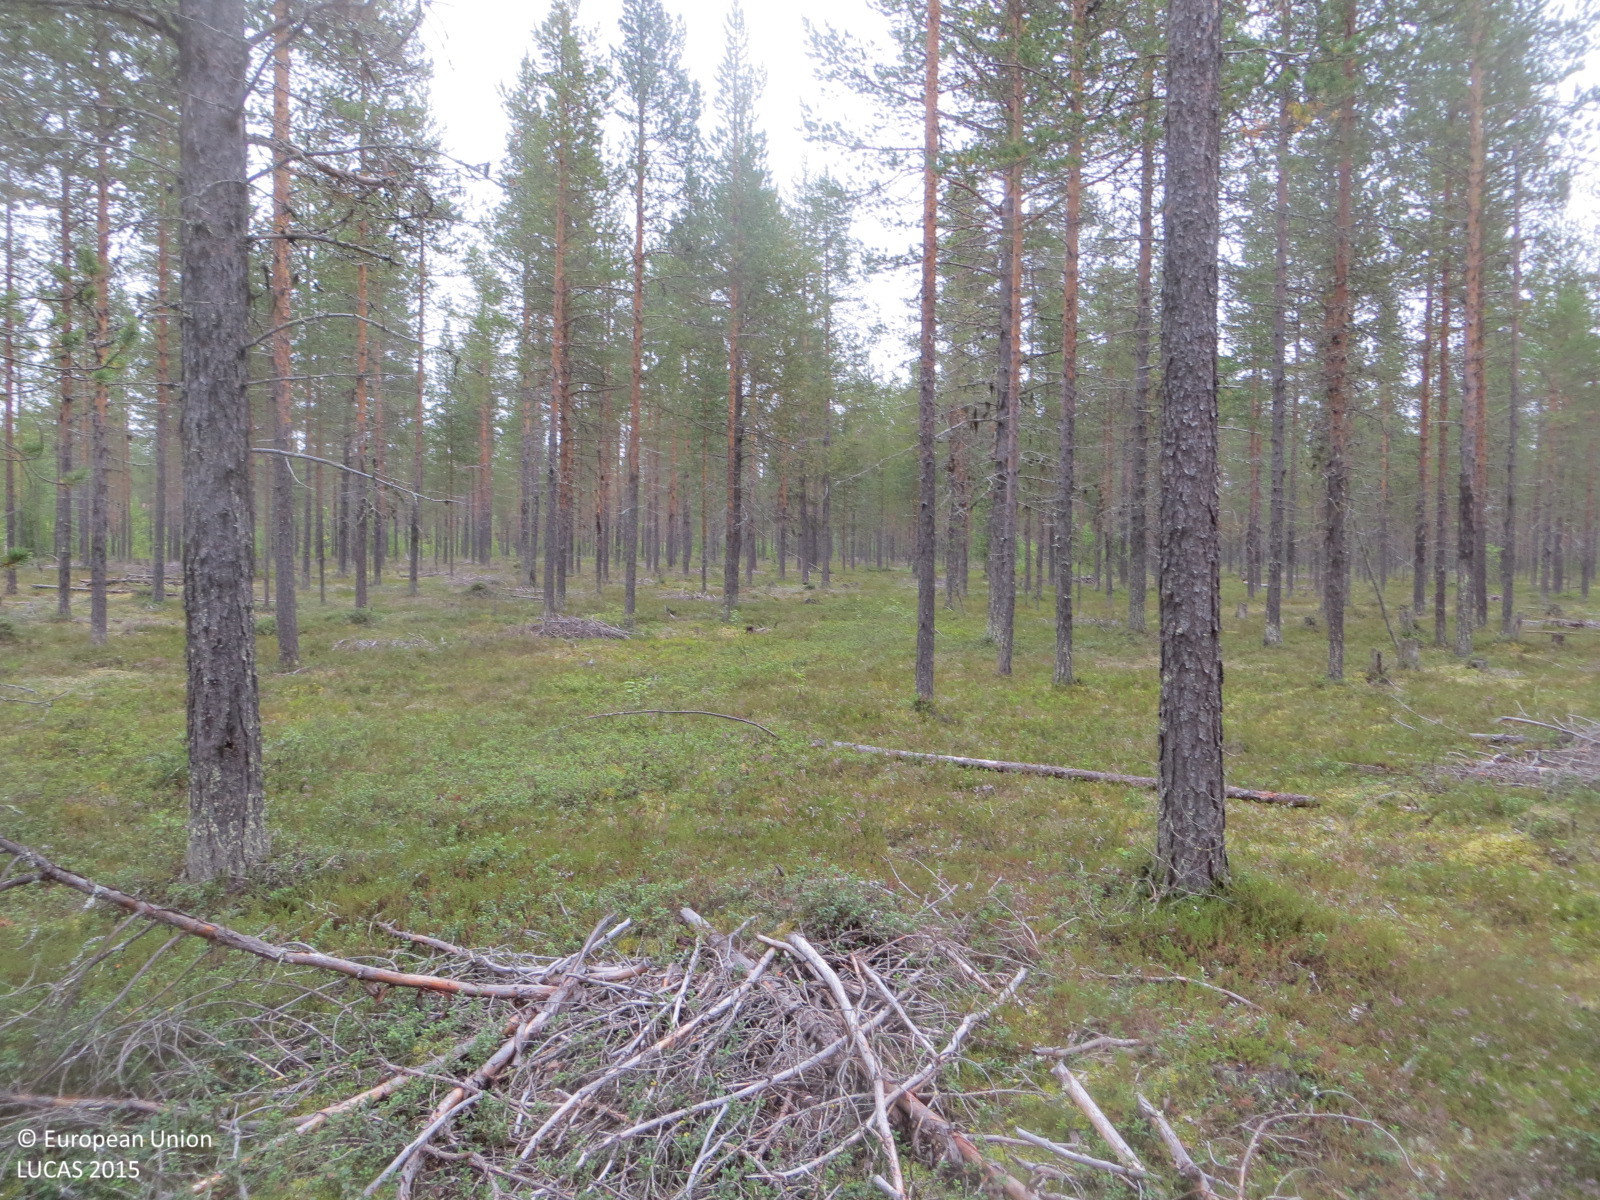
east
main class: Woodland
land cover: Pine dominated coniferous woodland
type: boreal forest
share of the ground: 50 - 75 %
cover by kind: coniferous forest trees 50 %, shrubs 25 %, lichens and mosses 25 %
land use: Forestry
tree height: > 5 m
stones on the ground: < 10 %
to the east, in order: Pine dominated coniferous woodland; Pine dominated mixed woodland; Ditches and canals; Pine dominated mixed woodland; Tracks; Other bare soil; Tracks
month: August
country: FI
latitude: 67.3644
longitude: 23.8295
